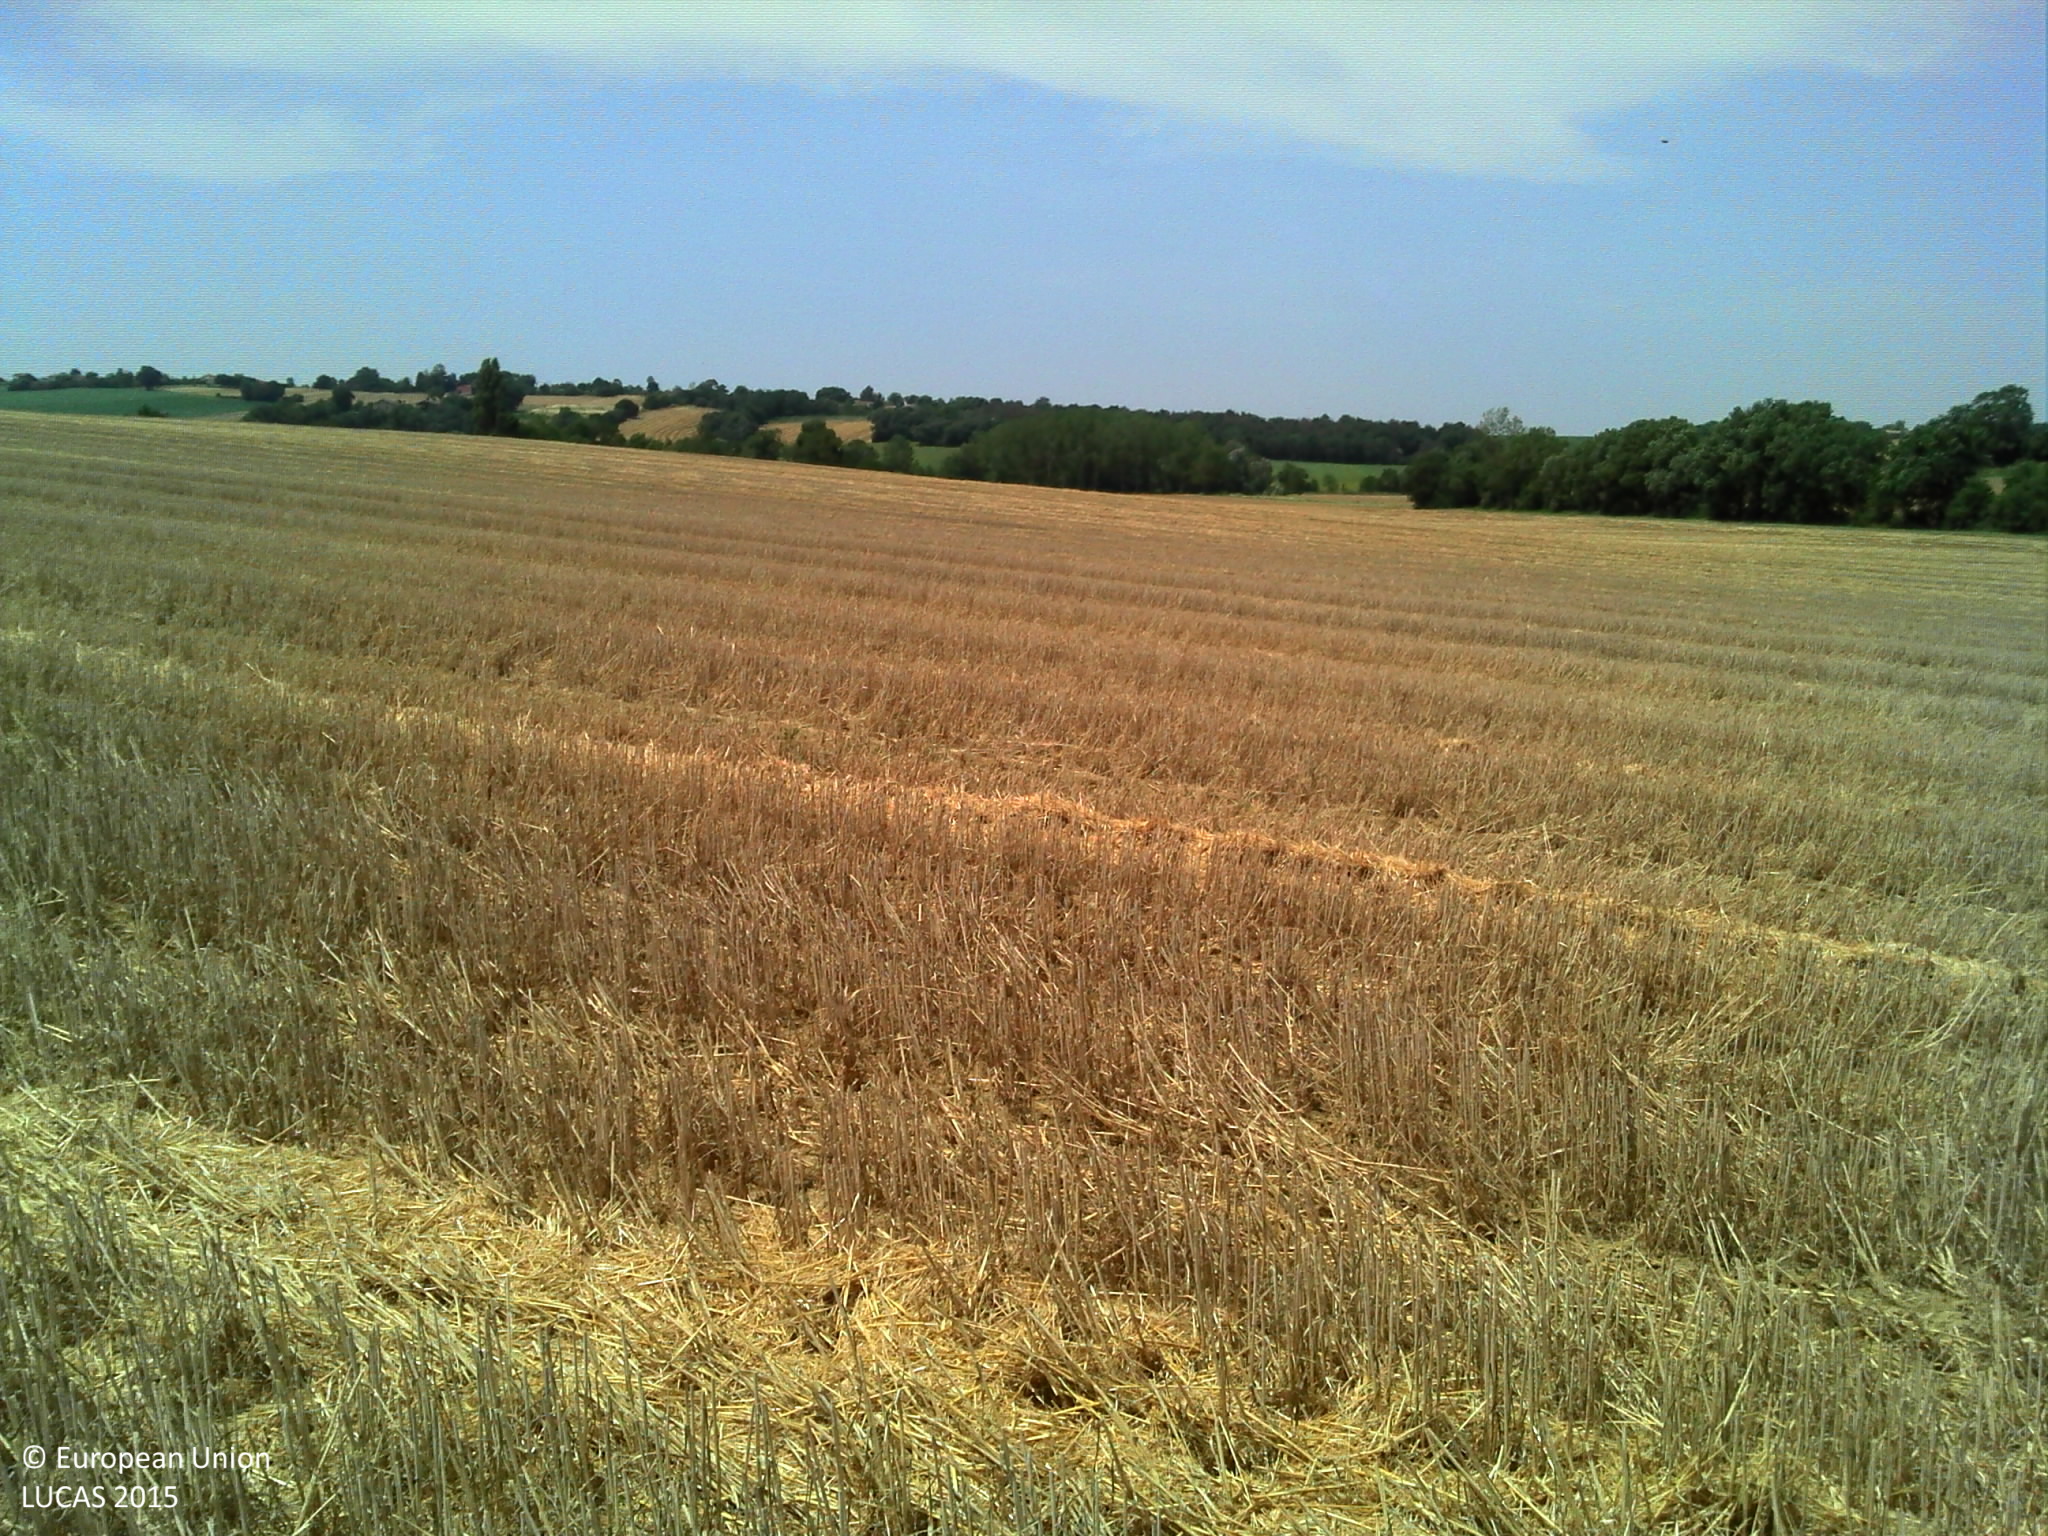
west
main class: Cropland
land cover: Durum wheat
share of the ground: > 75 %
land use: Agriculture (excluding fallow land and kitchen gardens)
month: July
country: FR
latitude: 43.5640
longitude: 1.0497
